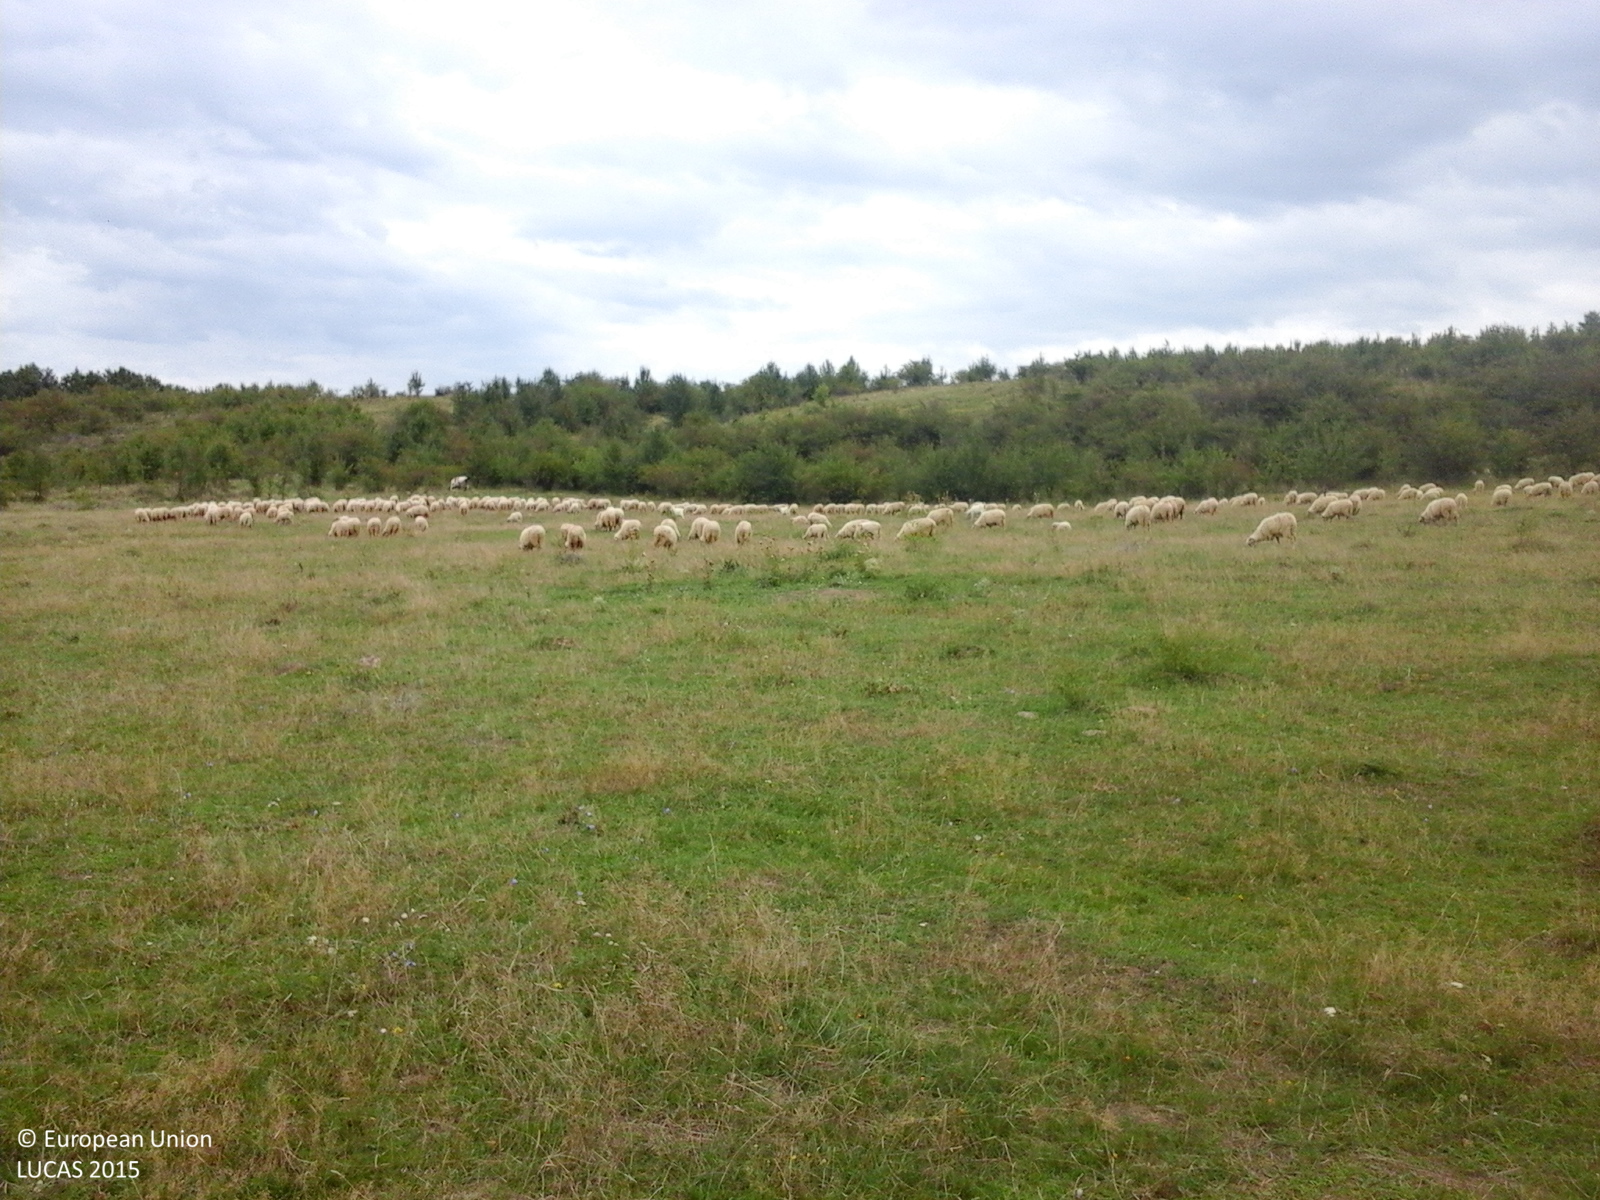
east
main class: Grassland
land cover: Grassland without tree/shrub cover
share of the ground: > 75 %
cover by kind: herbaceous plants 100 %
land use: Agriculture (excluding fallow land and kitchen gardens)
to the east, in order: Grassland without tree/shrub cover; Grassland with sparse tree/shrub cover; Shrubland with sparse tree cover; Grassland with sparse tree/shrub cover
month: September
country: RO
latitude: 47.4345
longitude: 22.6684
